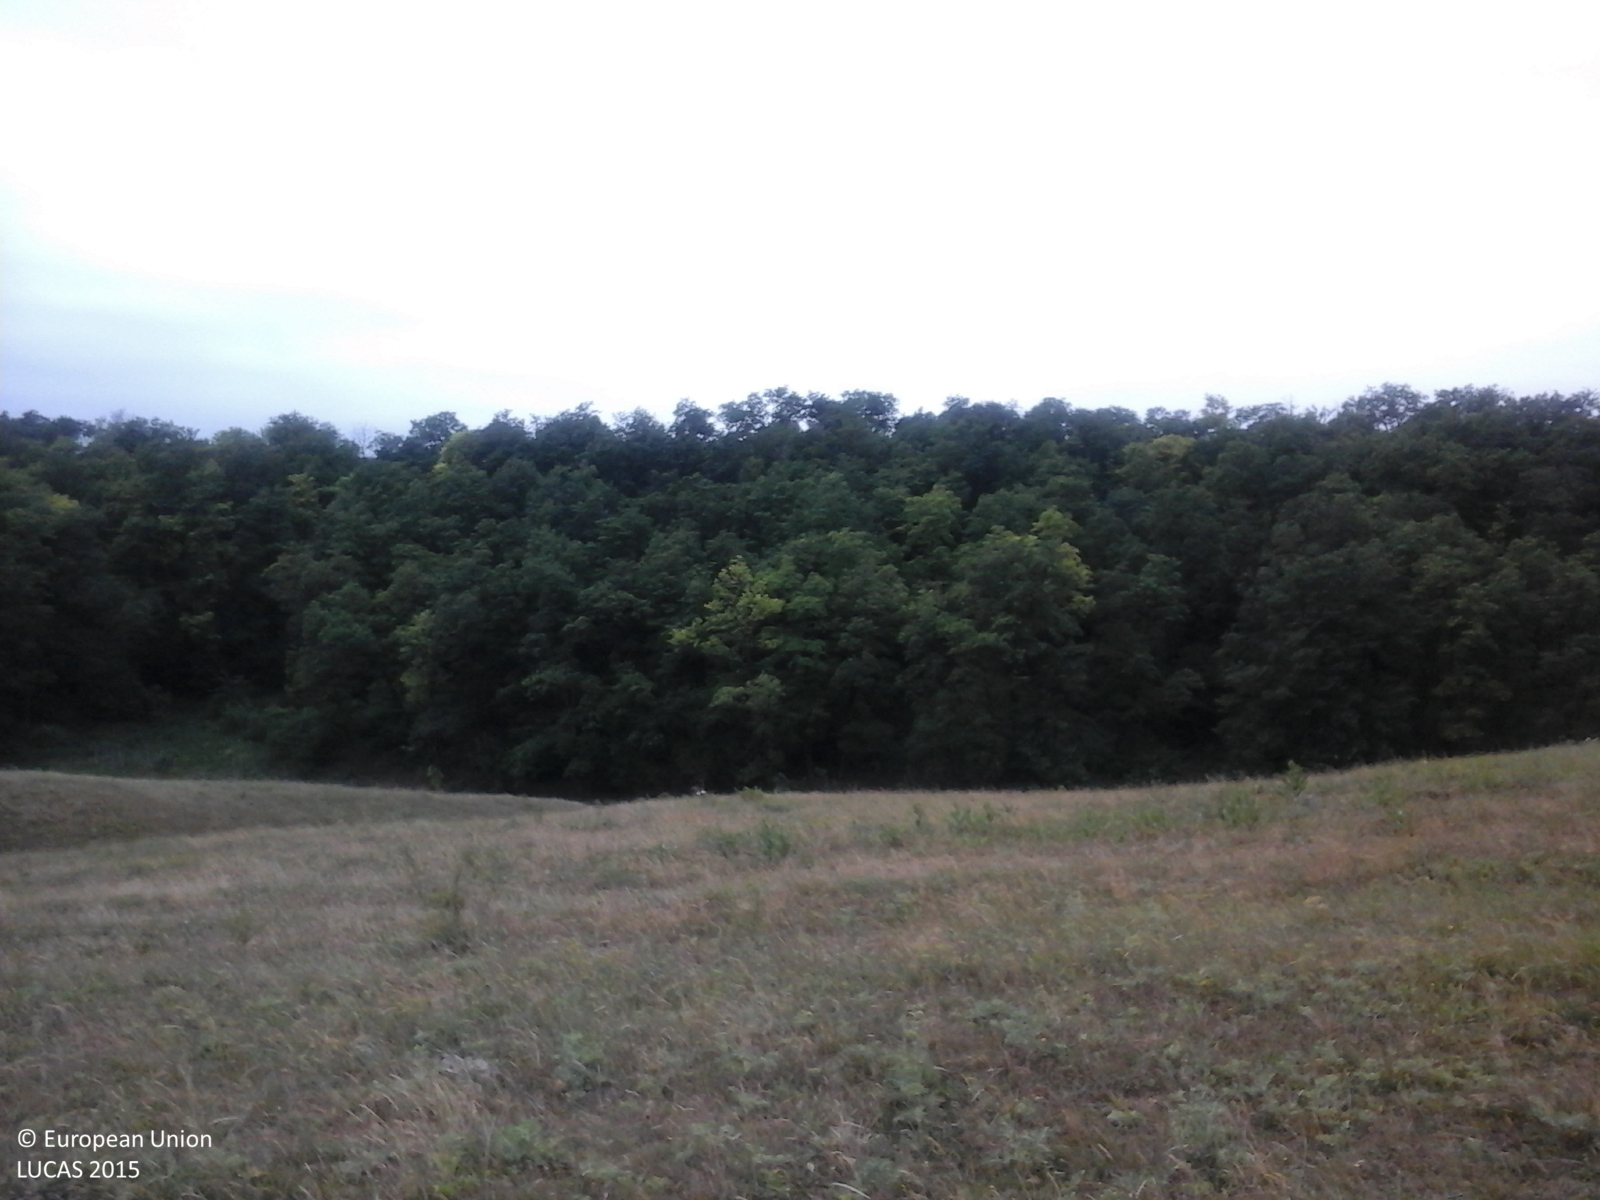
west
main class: Grassland
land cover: Grassland without tree/shrub cover
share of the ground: > 75 %
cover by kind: herbaceous plants 100 %
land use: Agriculture (excluding fallow land and kitchen gardens)
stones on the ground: < 10 %
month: June
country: RO
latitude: 46.8006
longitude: 26.6364
